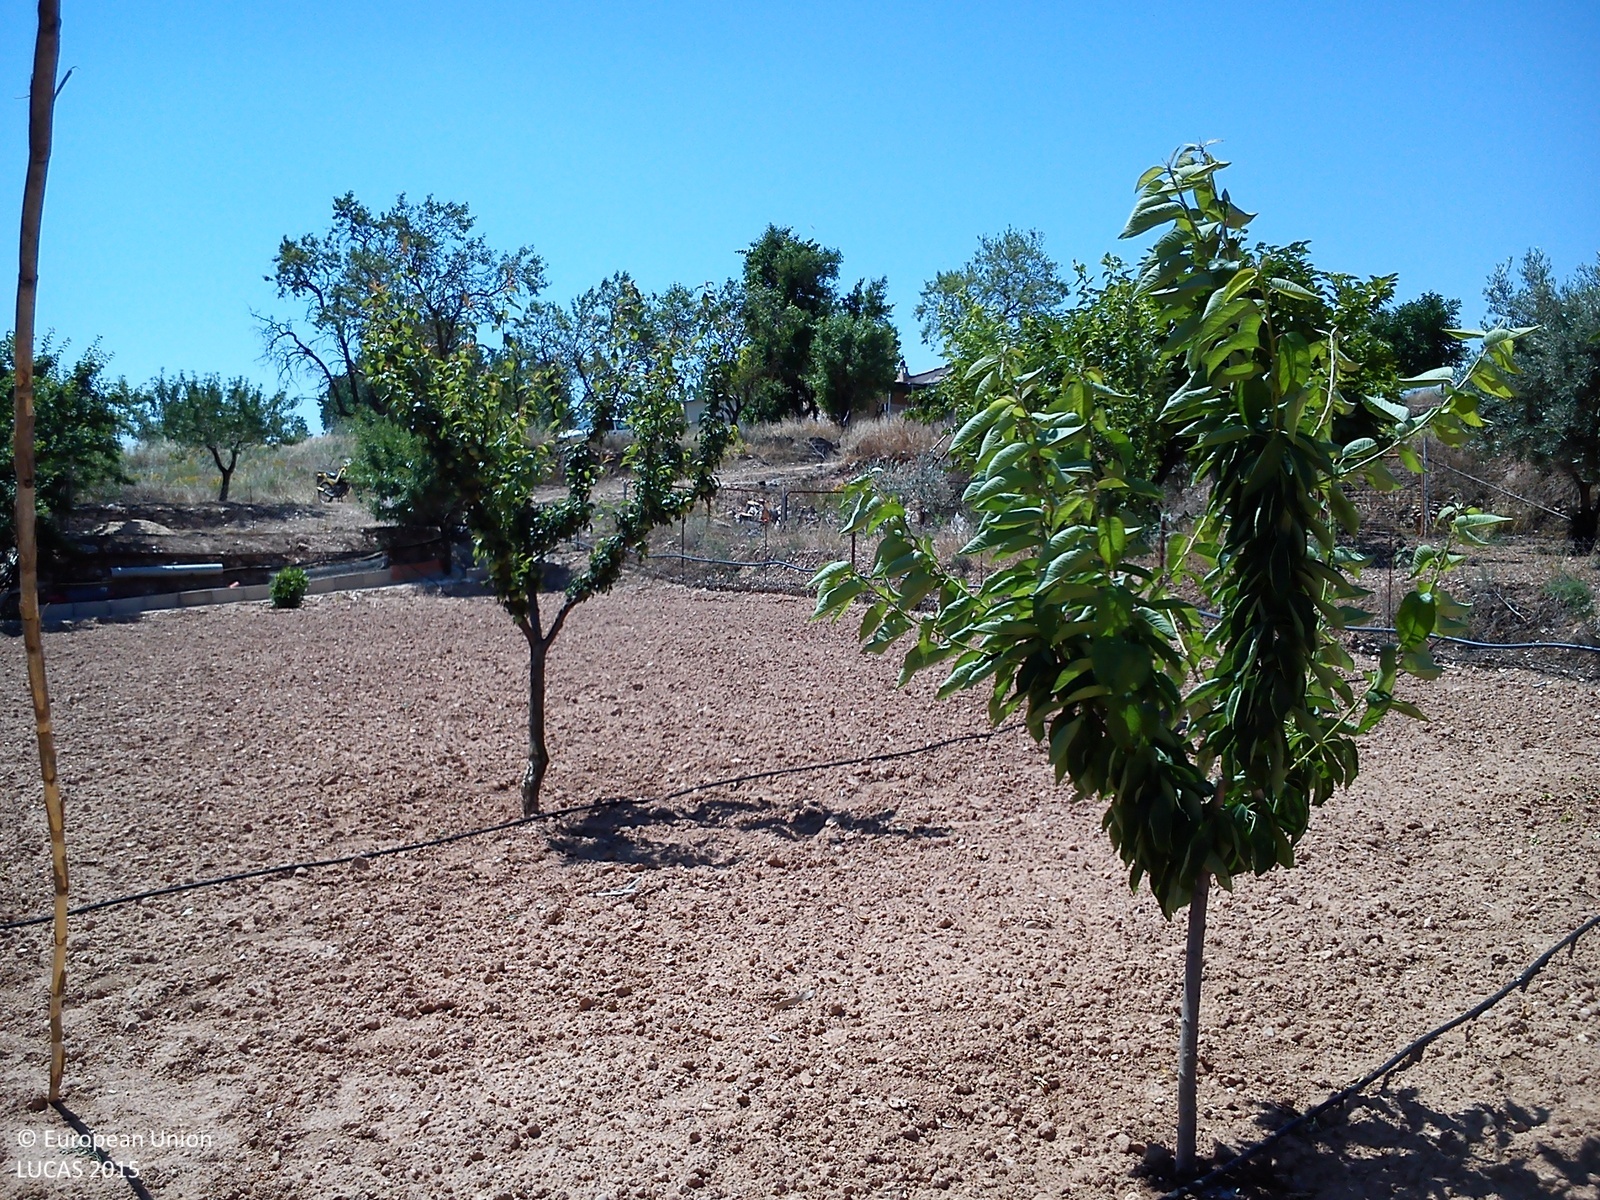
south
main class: Cropland
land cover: Cherry fruit
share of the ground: 10 - 25 %
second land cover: Other bare soil
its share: > 75 %
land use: Agriculture (excluding fallow land and kitchen gardens)
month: June
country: ES
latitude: 39.2203
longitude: -1.0595
